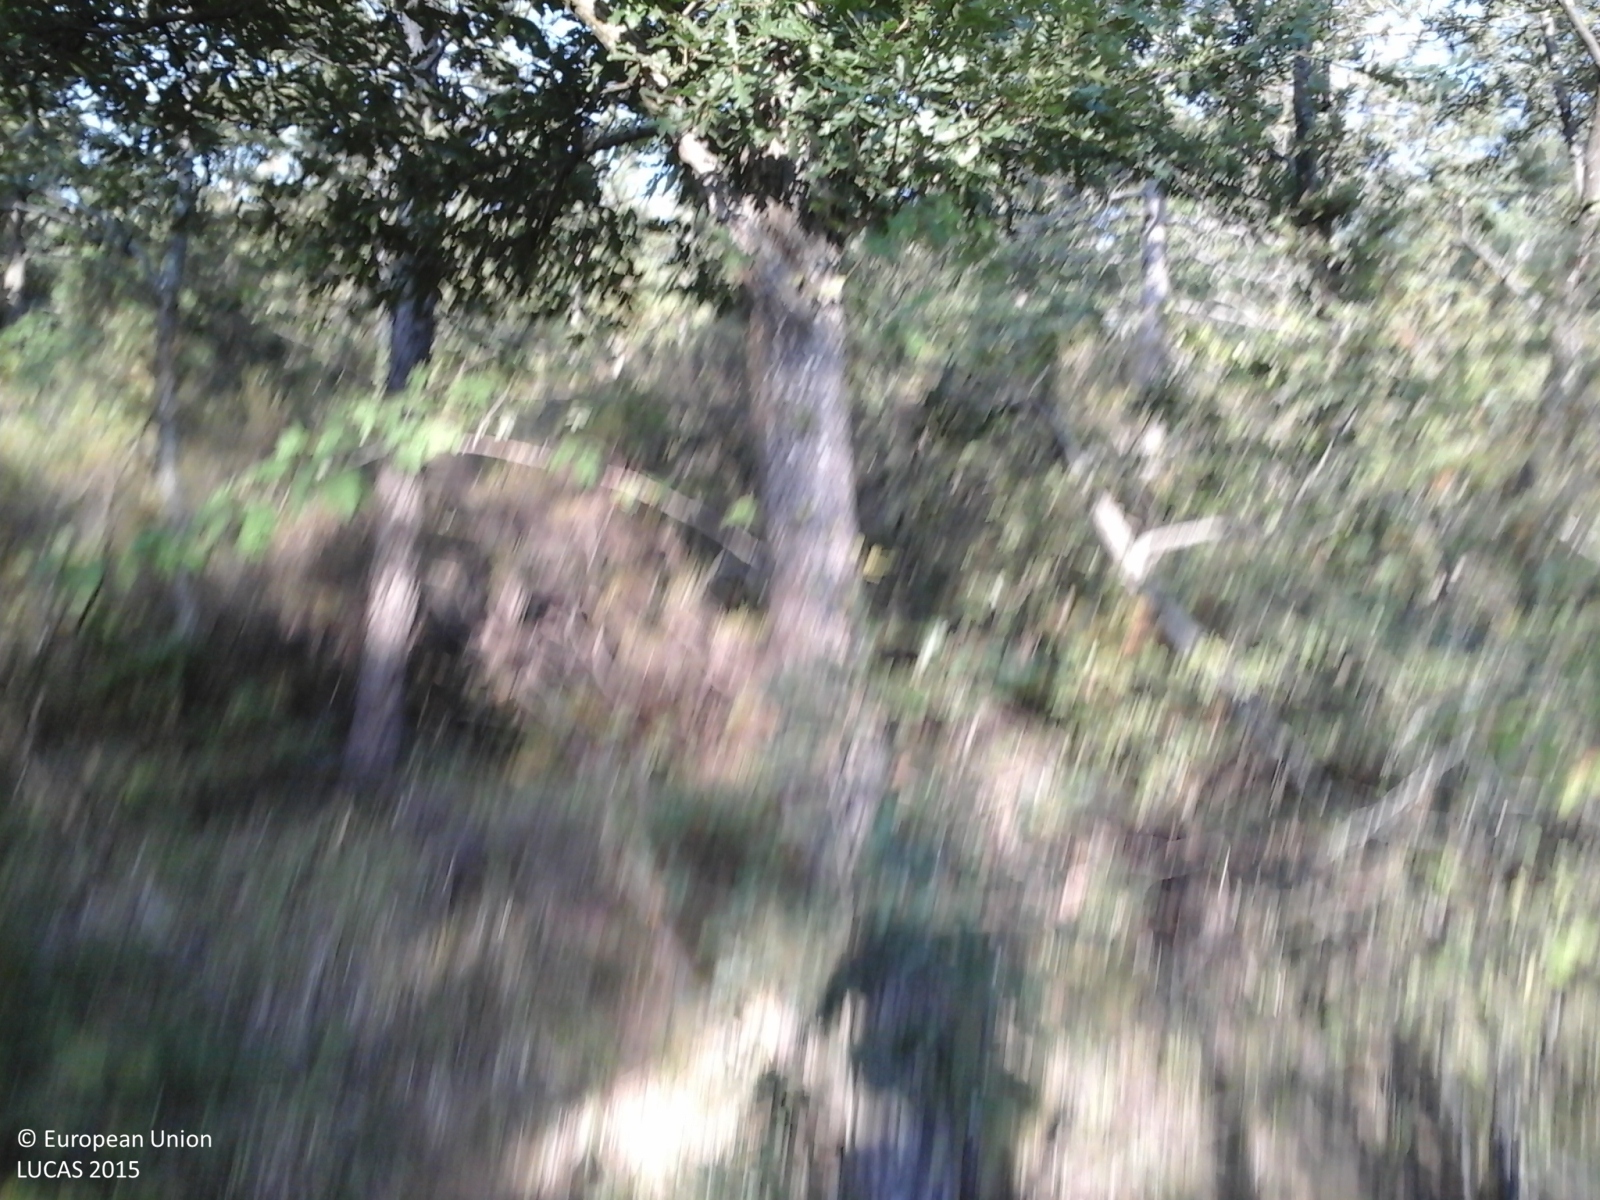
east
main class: Woodland
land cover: Pine dominated mixed woodland
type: coniferous forest of the mediterranean region
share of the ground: > 75 %
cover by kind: coniferous forest trees 45 %, broadleaved forest trees 25 %, shrubs 20 %, herbaceous plants 10 %
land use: Forestry
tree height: > 5 m
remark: Clear cut
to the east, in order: Pine dominated mixed woodland; Electric lines; Grass margins; Paved roads, cycling and walking lanes; Grass margins; Pine dominated mixed woodland
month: August
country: IT
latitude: 42.7856
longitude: 11.6206
